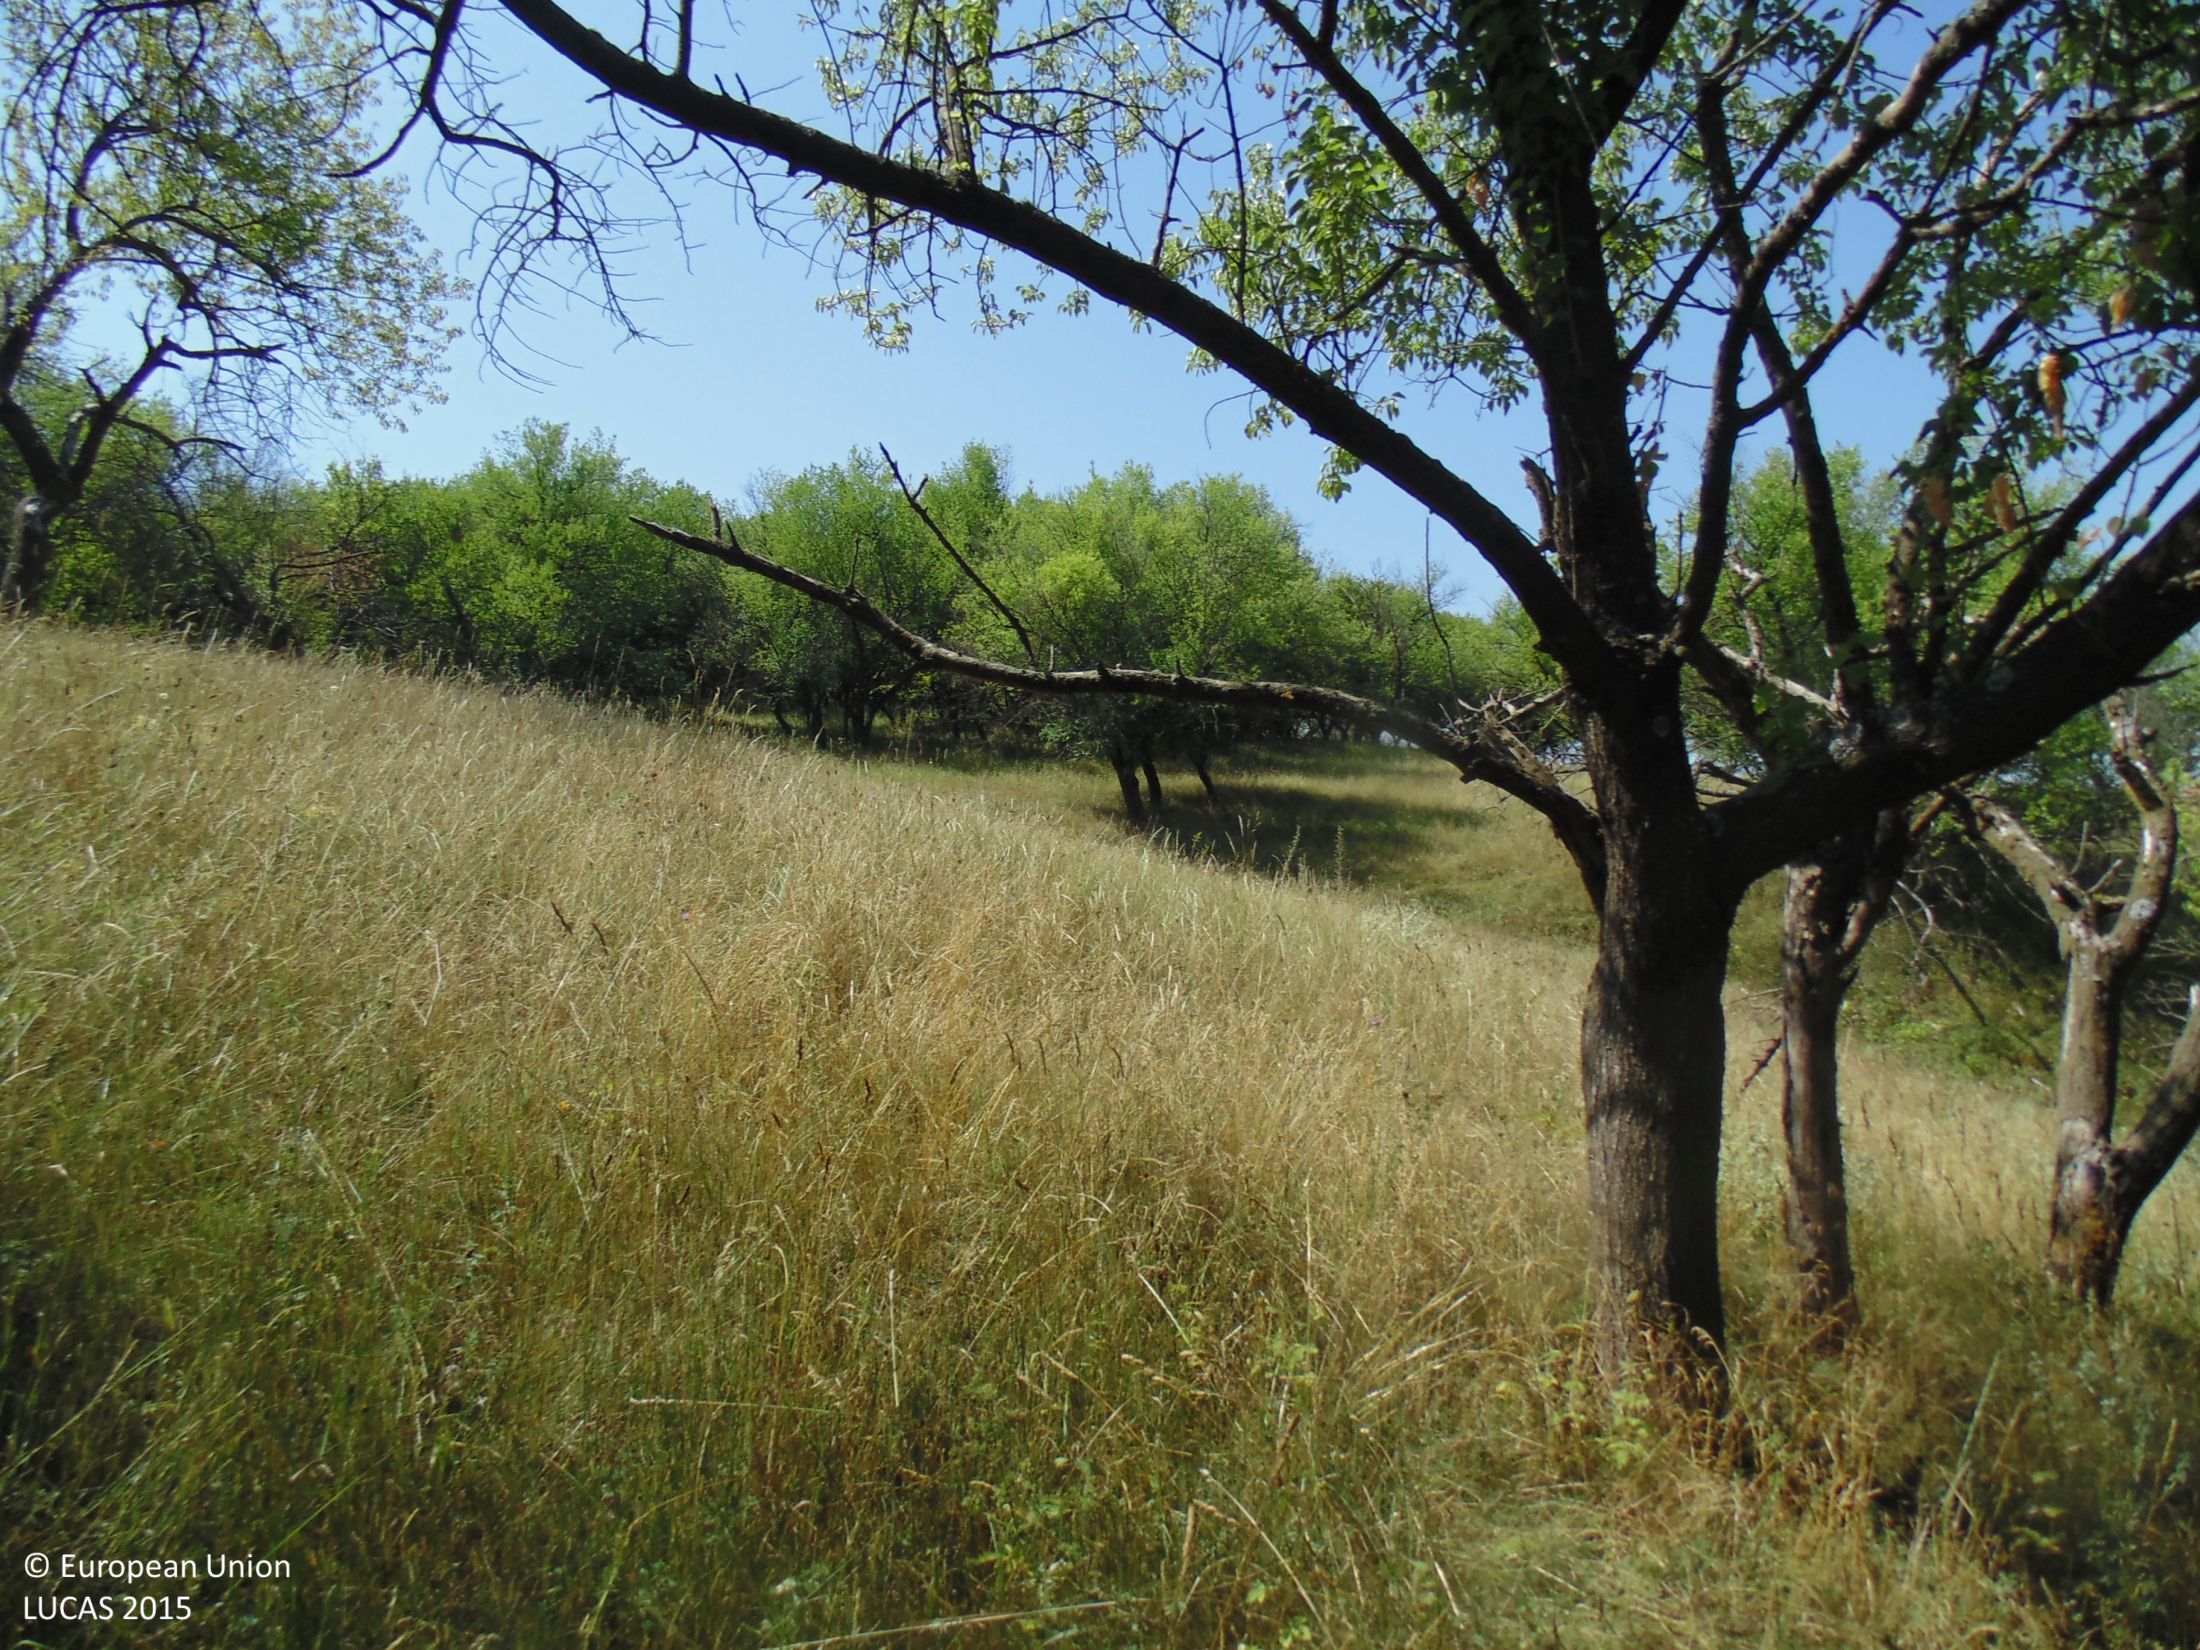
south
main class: Woodland
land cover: Broadleaved woodland
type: mesophytic deciduous forest
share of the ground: 50 - 75 %
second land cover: Grassland without tree/shrub cover
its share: > 75 %
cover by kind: broadleaved forest trees 70 %, herbaceous plants 30 %
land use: Forestry
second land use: Agriculture (excluding fallow land and kitchen gardens)
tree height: > 5 m
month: July
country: BG
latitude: 43.5166
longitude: 27.7929
